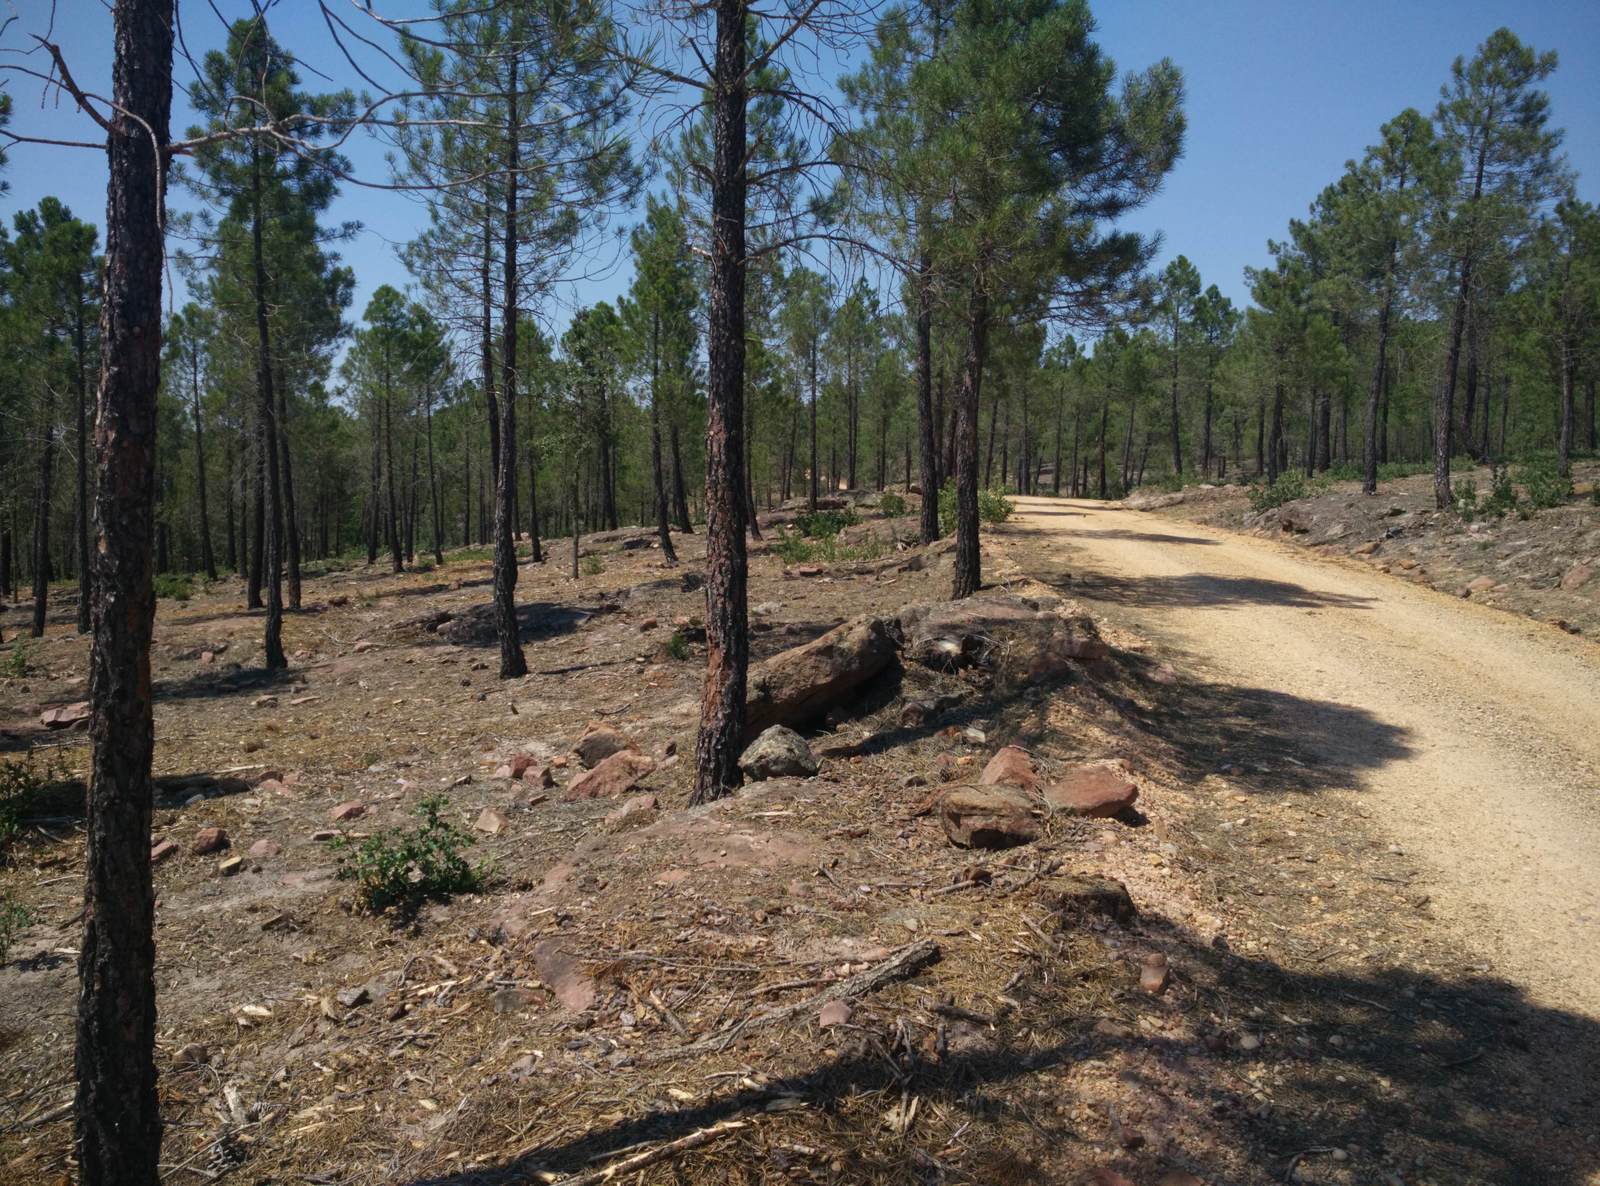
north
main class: Woodland
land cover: Pine dominated coniferous woodland
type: coniferous forest of the mediterranean region
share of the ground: 25 - 50 %
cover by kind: unconsolidated bare surface 50 %, coniferous forest trees 40 %, shrubs 10 %
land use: Semi-natural and natural areas not in use
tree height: > 5 m
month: July
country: ES
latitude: 40.8684
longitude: -2.0910
